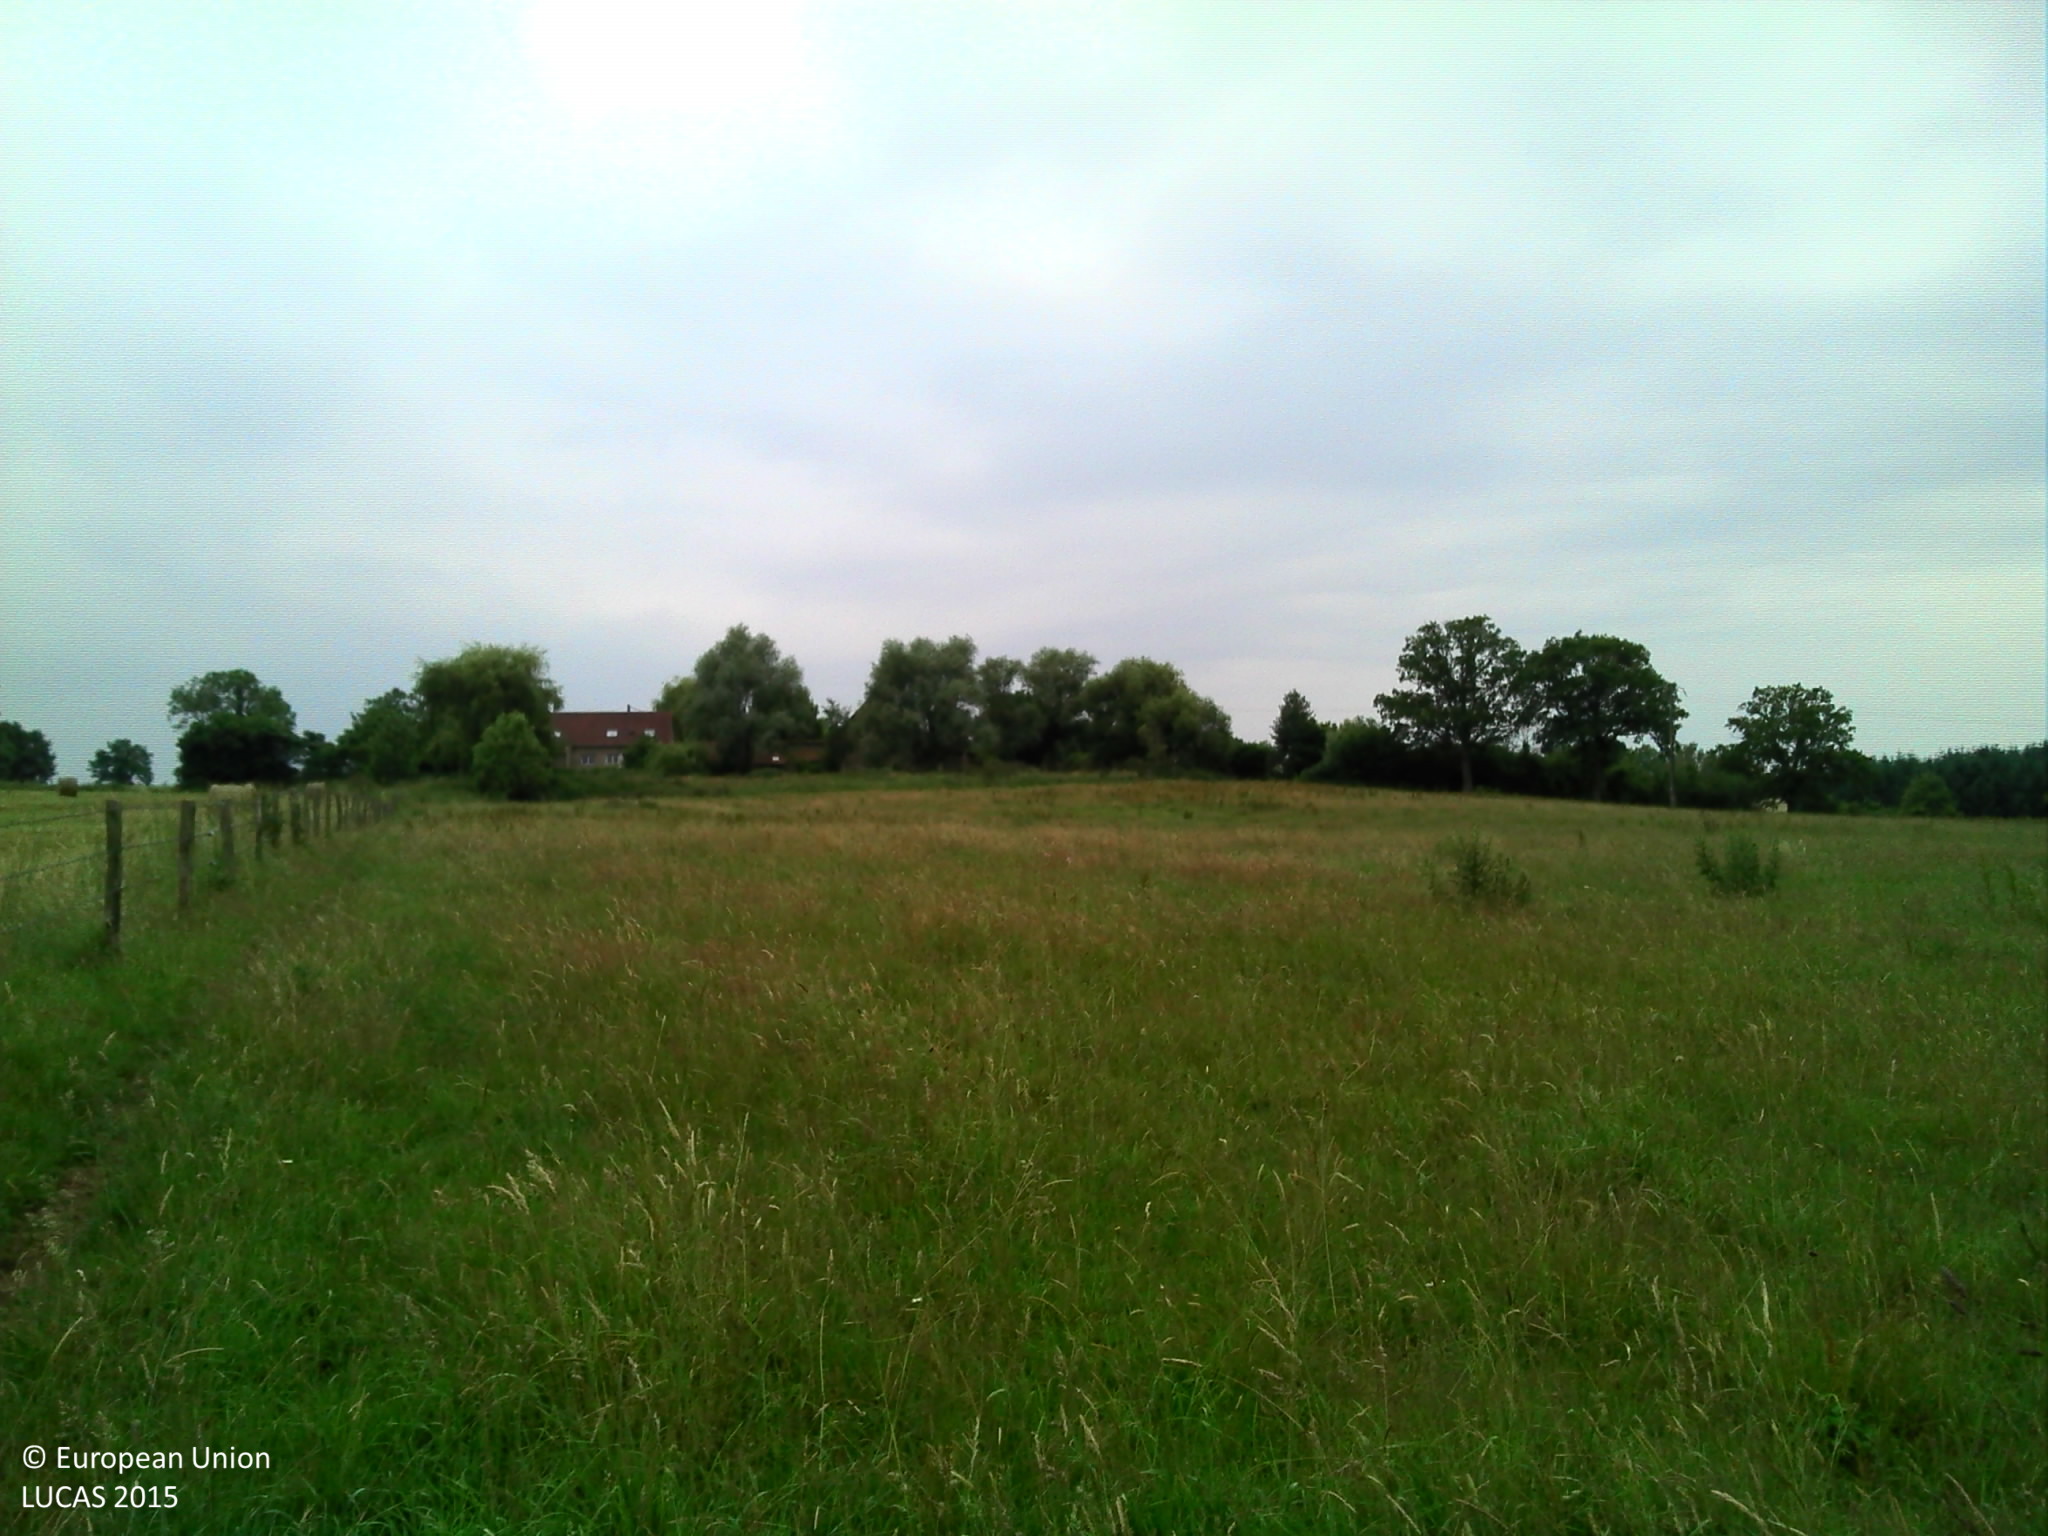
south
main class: Grassland
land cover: Grassland without tree/shrub cover
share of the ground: > 75 %
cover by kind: herbaceous plants 100 %
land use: Agriculture (excluding fallow land and kitchen gardens)
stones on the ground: < 10 %
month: June
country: FR
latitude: 46.6112
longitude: 2.7492
